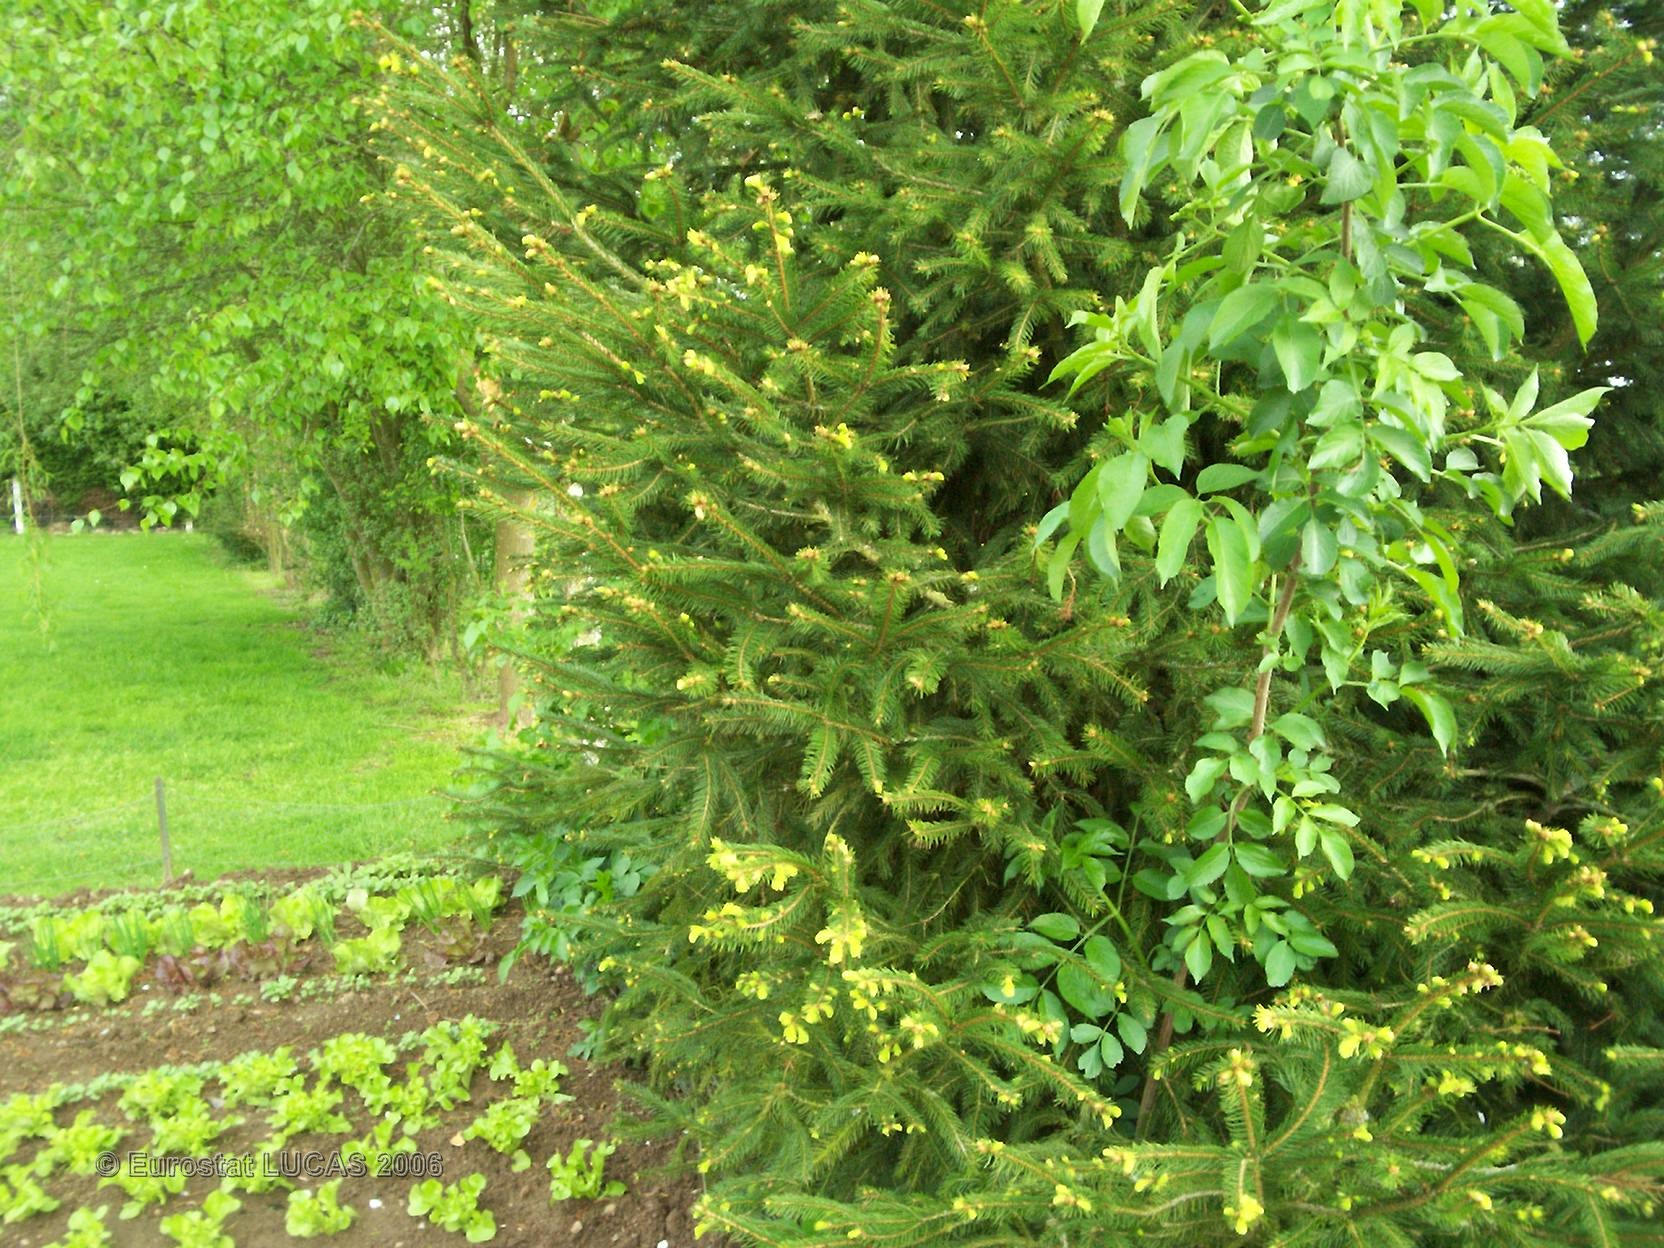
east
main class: Cropland
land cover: Other fresh vegetables
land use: Kitchen garden
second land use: Residential
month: May
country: FR
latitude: 49.1218
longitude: 0.5609
